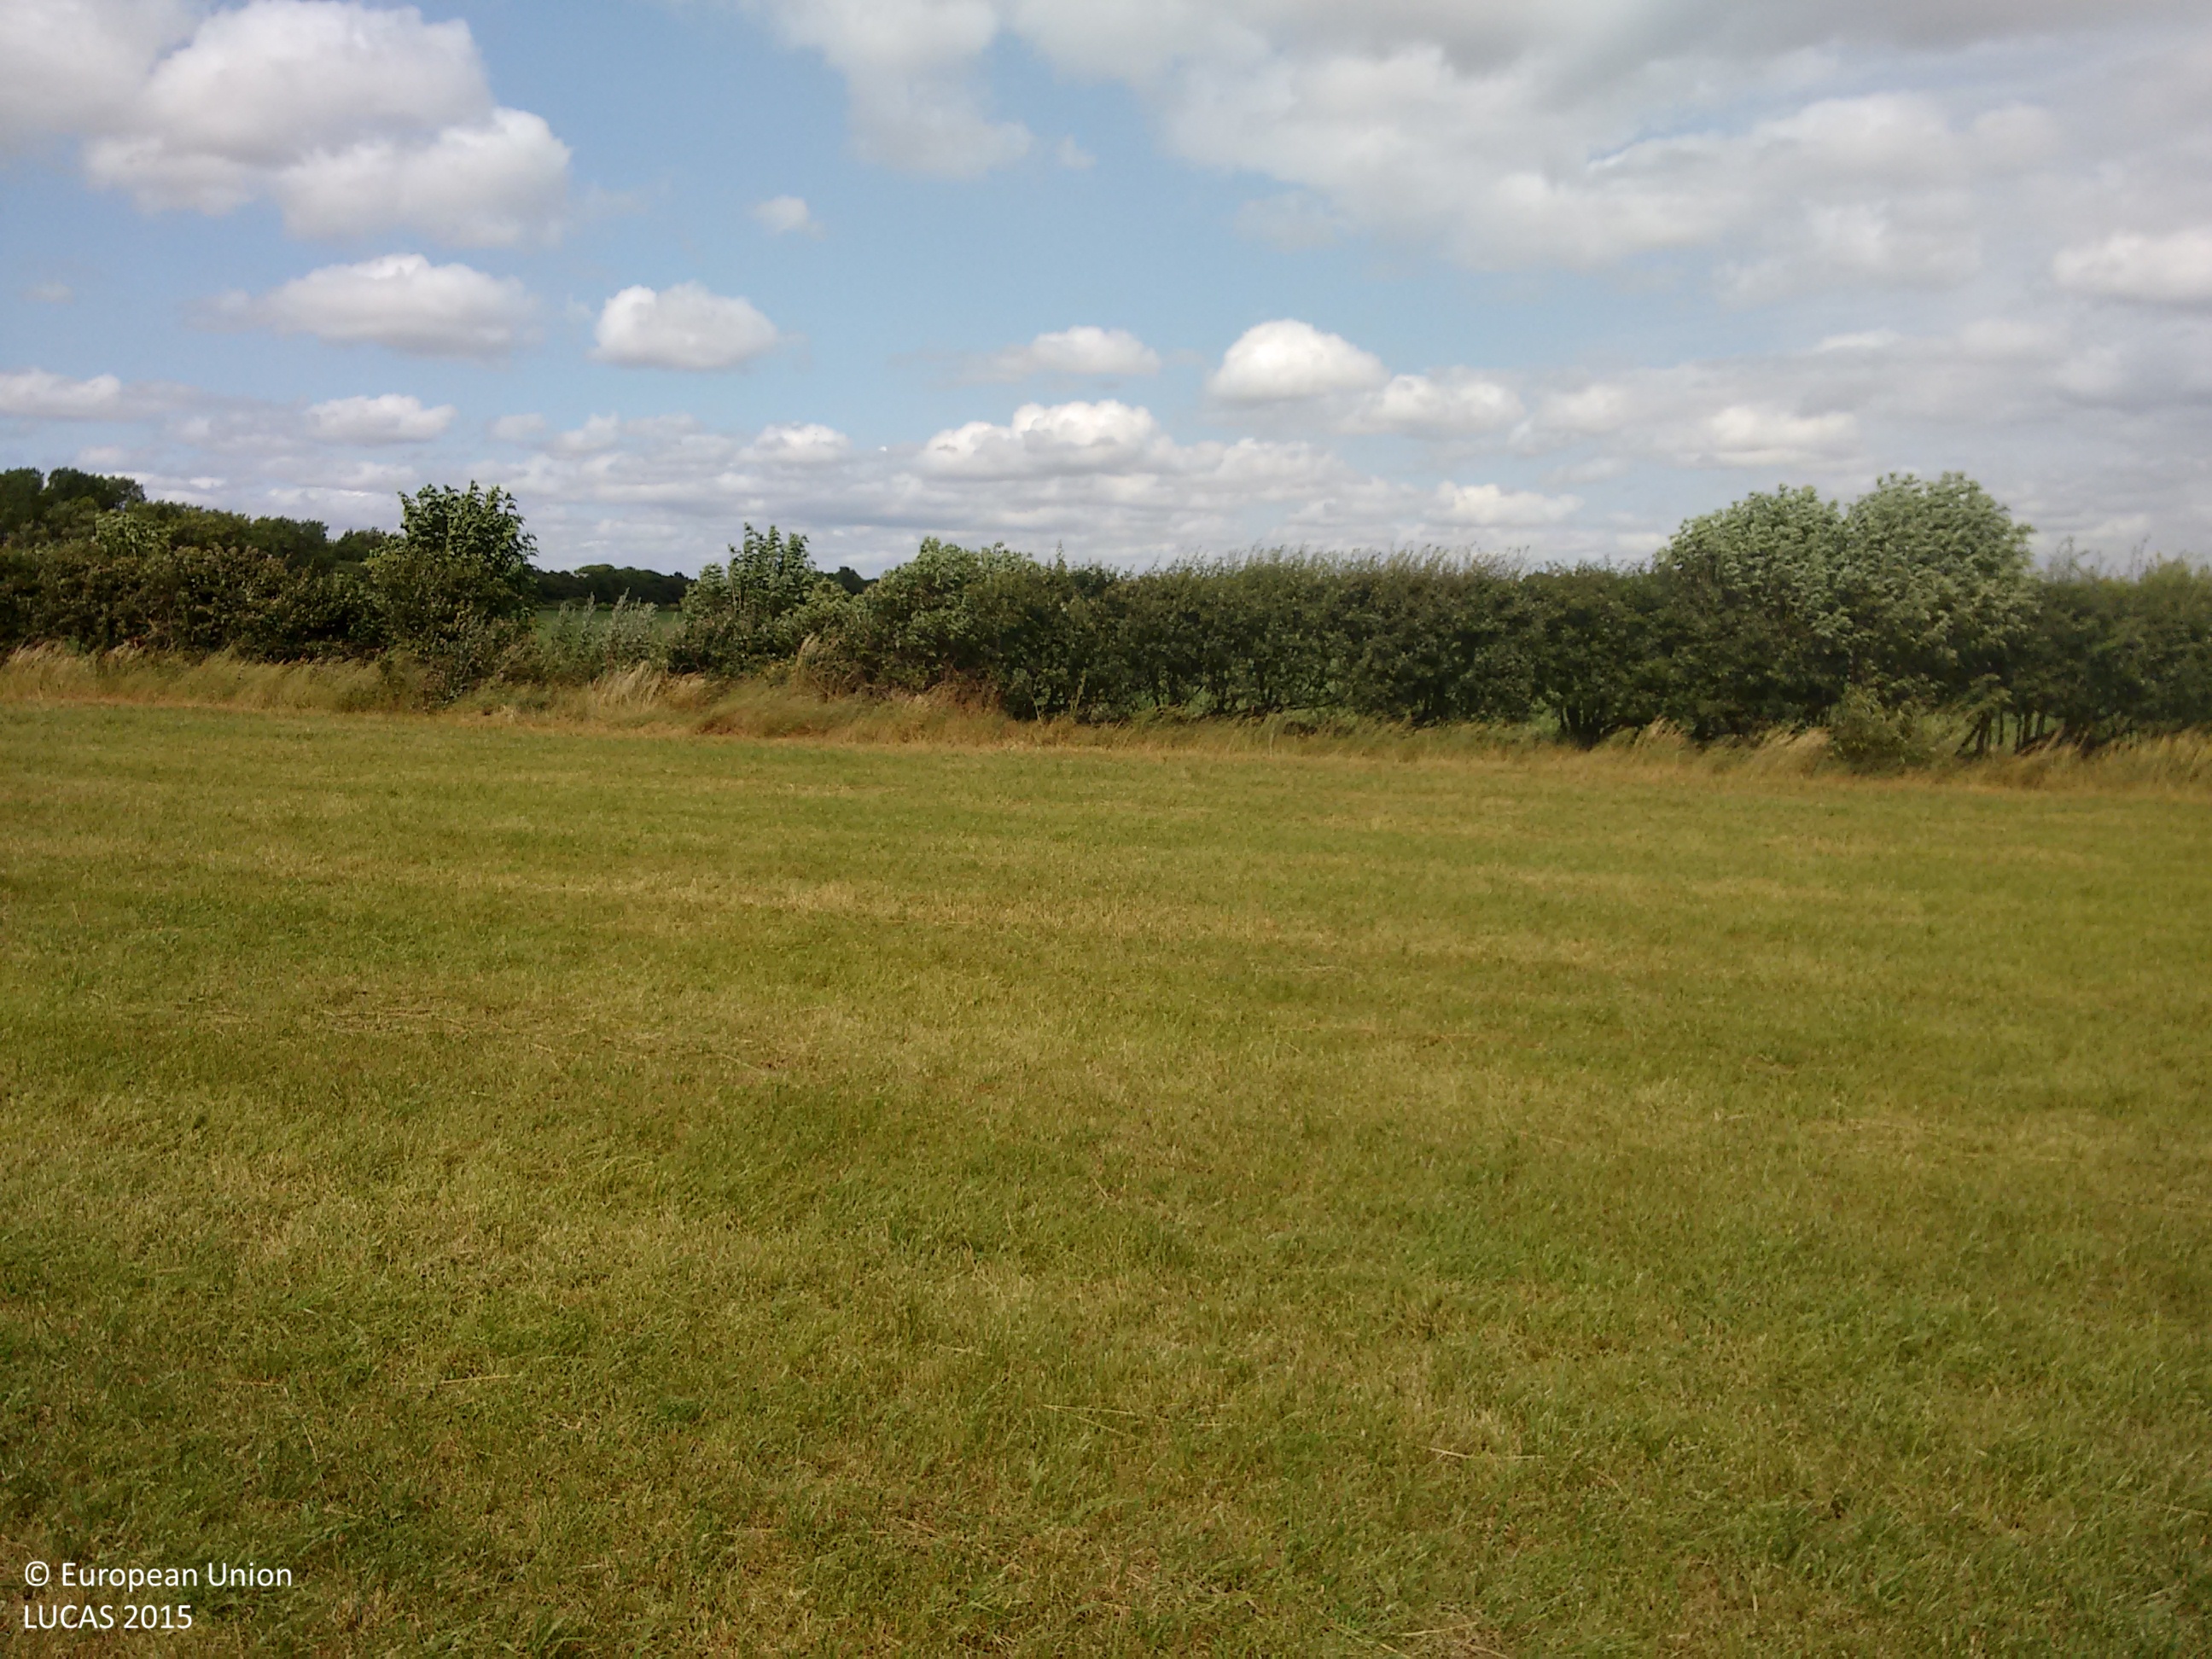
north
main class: Grassland
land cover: Grassland without tree/shrub cover
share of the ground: > 75 %
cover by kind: herbaceous plants 100 %
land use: Agriculture (excluding fallow land and kitchen gardens)
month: July
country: GB
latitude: 53.1158
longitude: -0.8136
